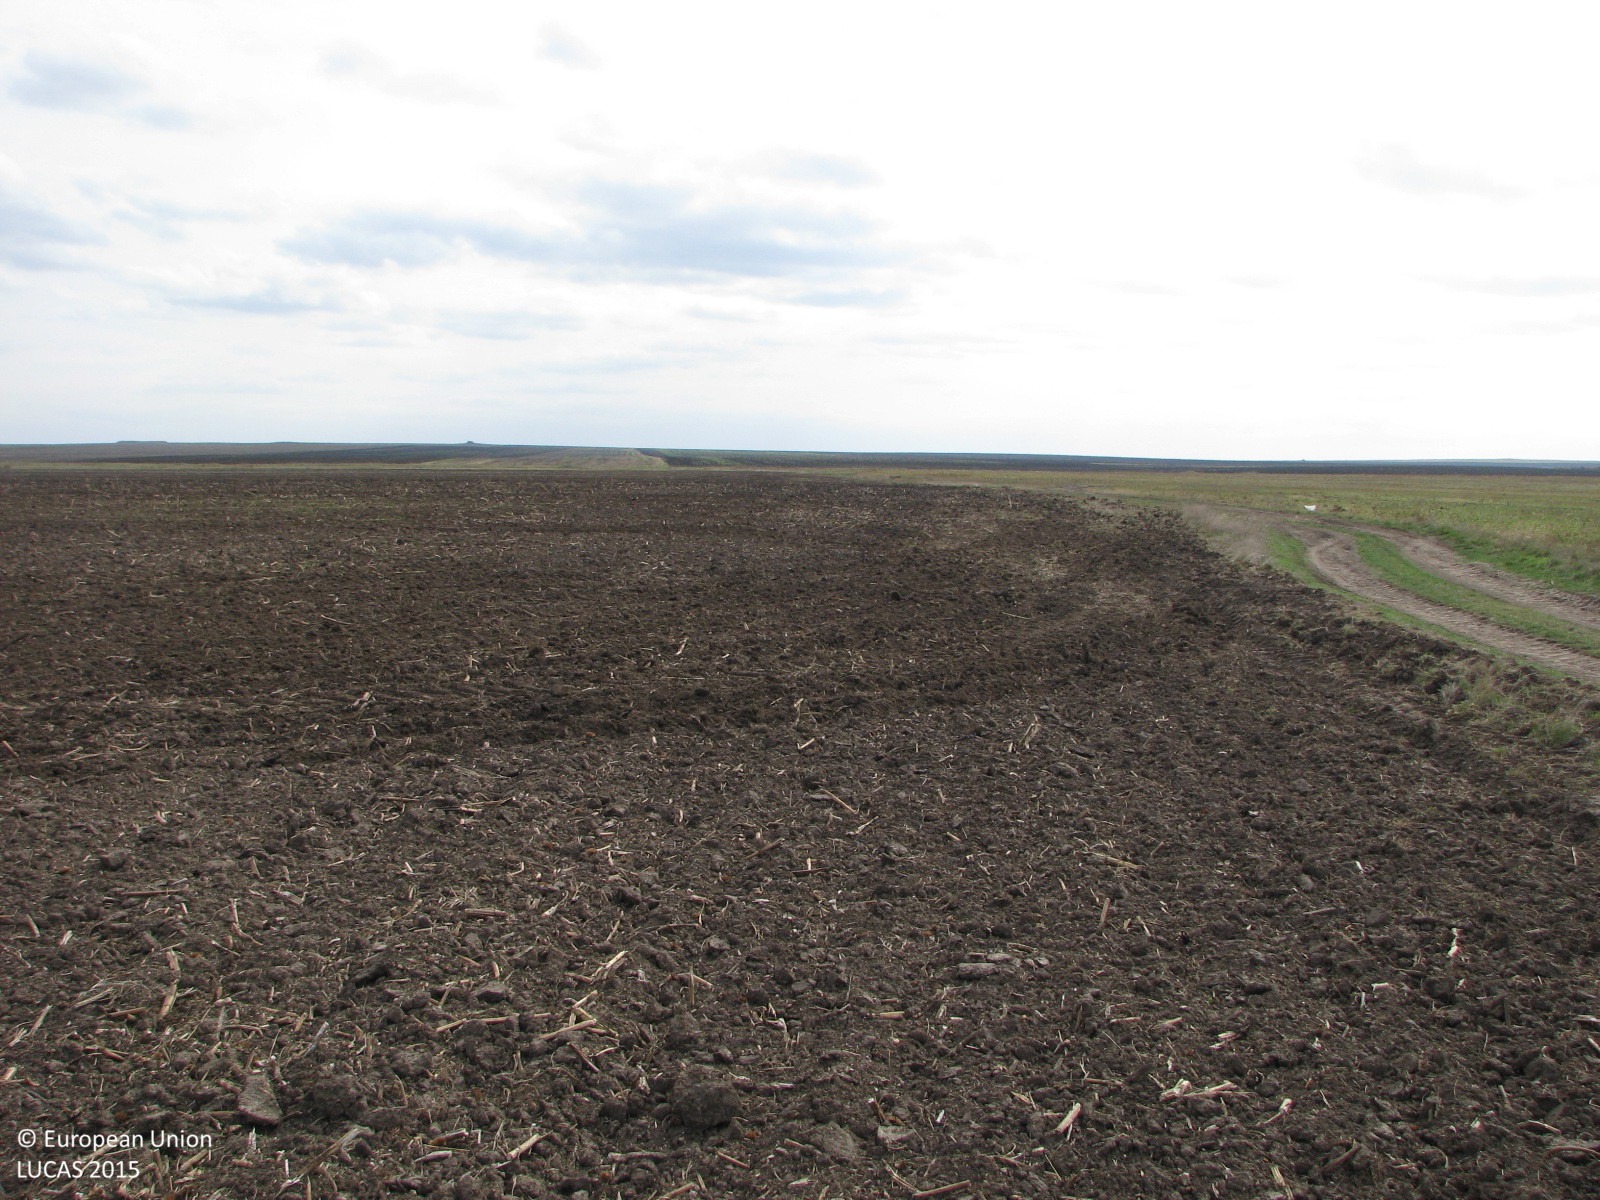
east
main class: Cropland
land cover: Sunflower
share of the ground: < 10 %
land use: Agriculture (excluding fallow land and kitchen gardens)
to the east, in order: Sunflower
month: October
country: BG
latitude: 42.4789
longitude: 26.2030
